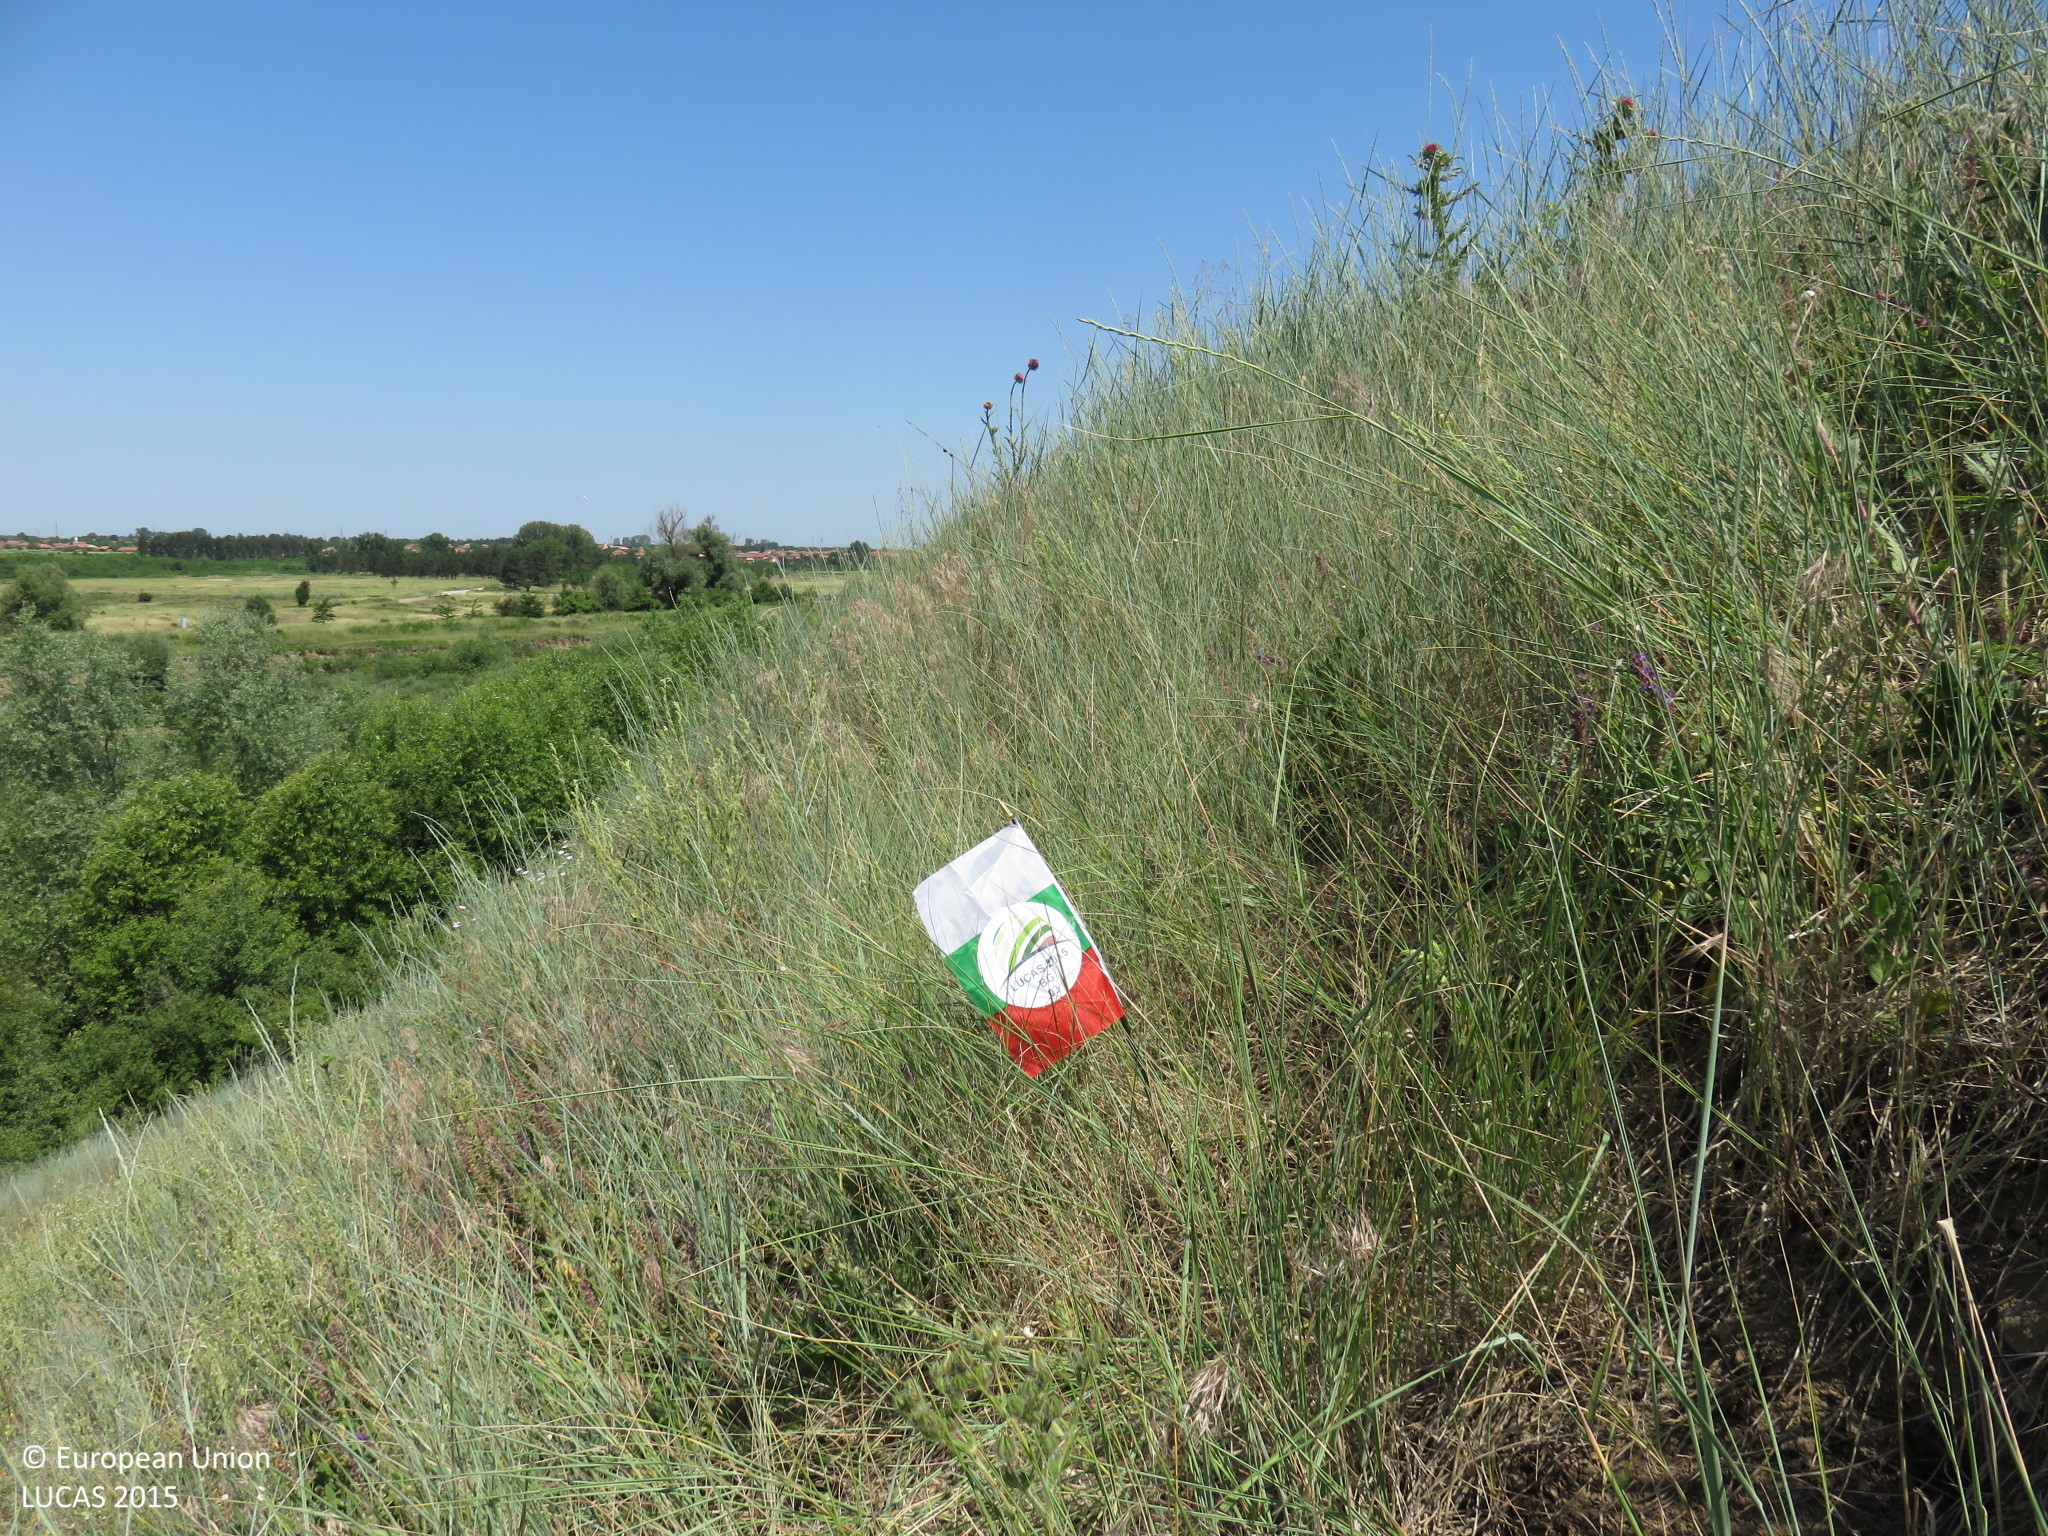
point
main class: Grassland
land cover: Grassland without tree/shrub cover
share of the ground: > 75 %
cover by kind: herbaceous plants 100 %
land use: Agriculture (excluding fallow land and kitchen gardens)
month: June
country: BG
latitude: 43.3360
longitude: 24.4279
